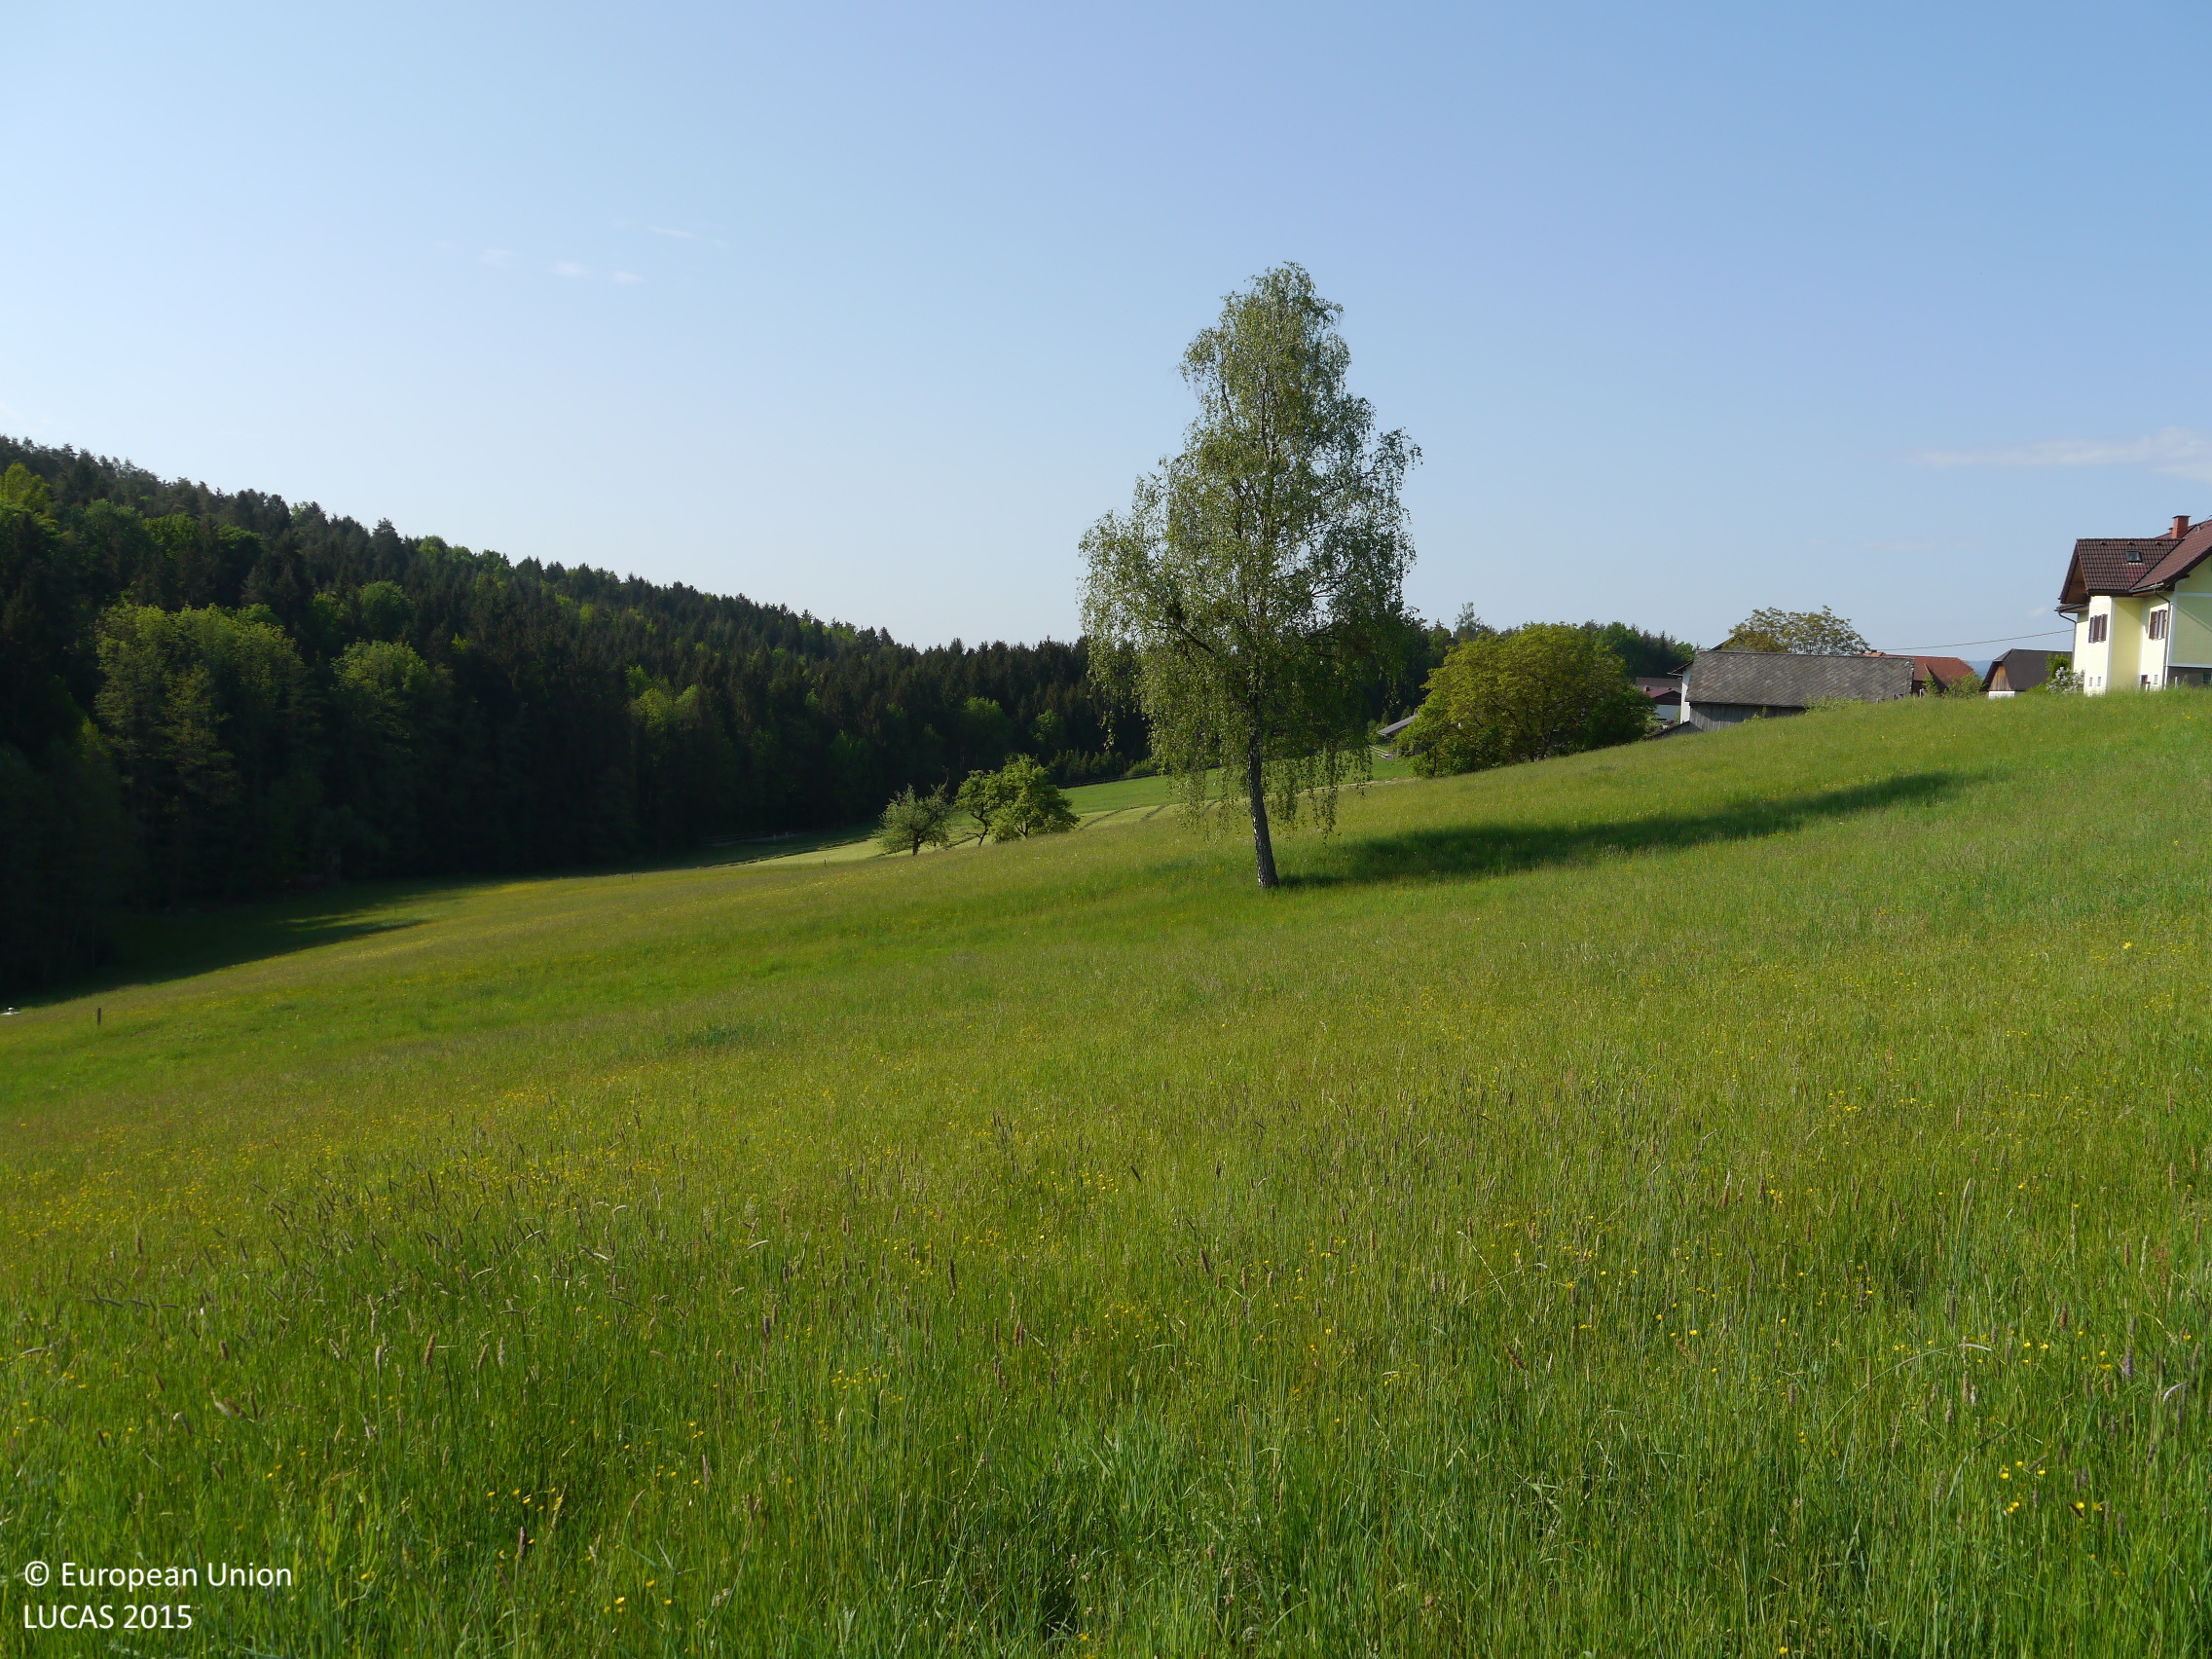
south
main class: Grassland
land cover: Grassland without tree/shrub cover
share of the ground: > 75 %
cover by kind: herbaceous plants 100 %
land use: Agriculture (excluding fallow land and kitchen gardens)
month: May
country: AT
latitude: 47.0331
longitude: 15.2763
